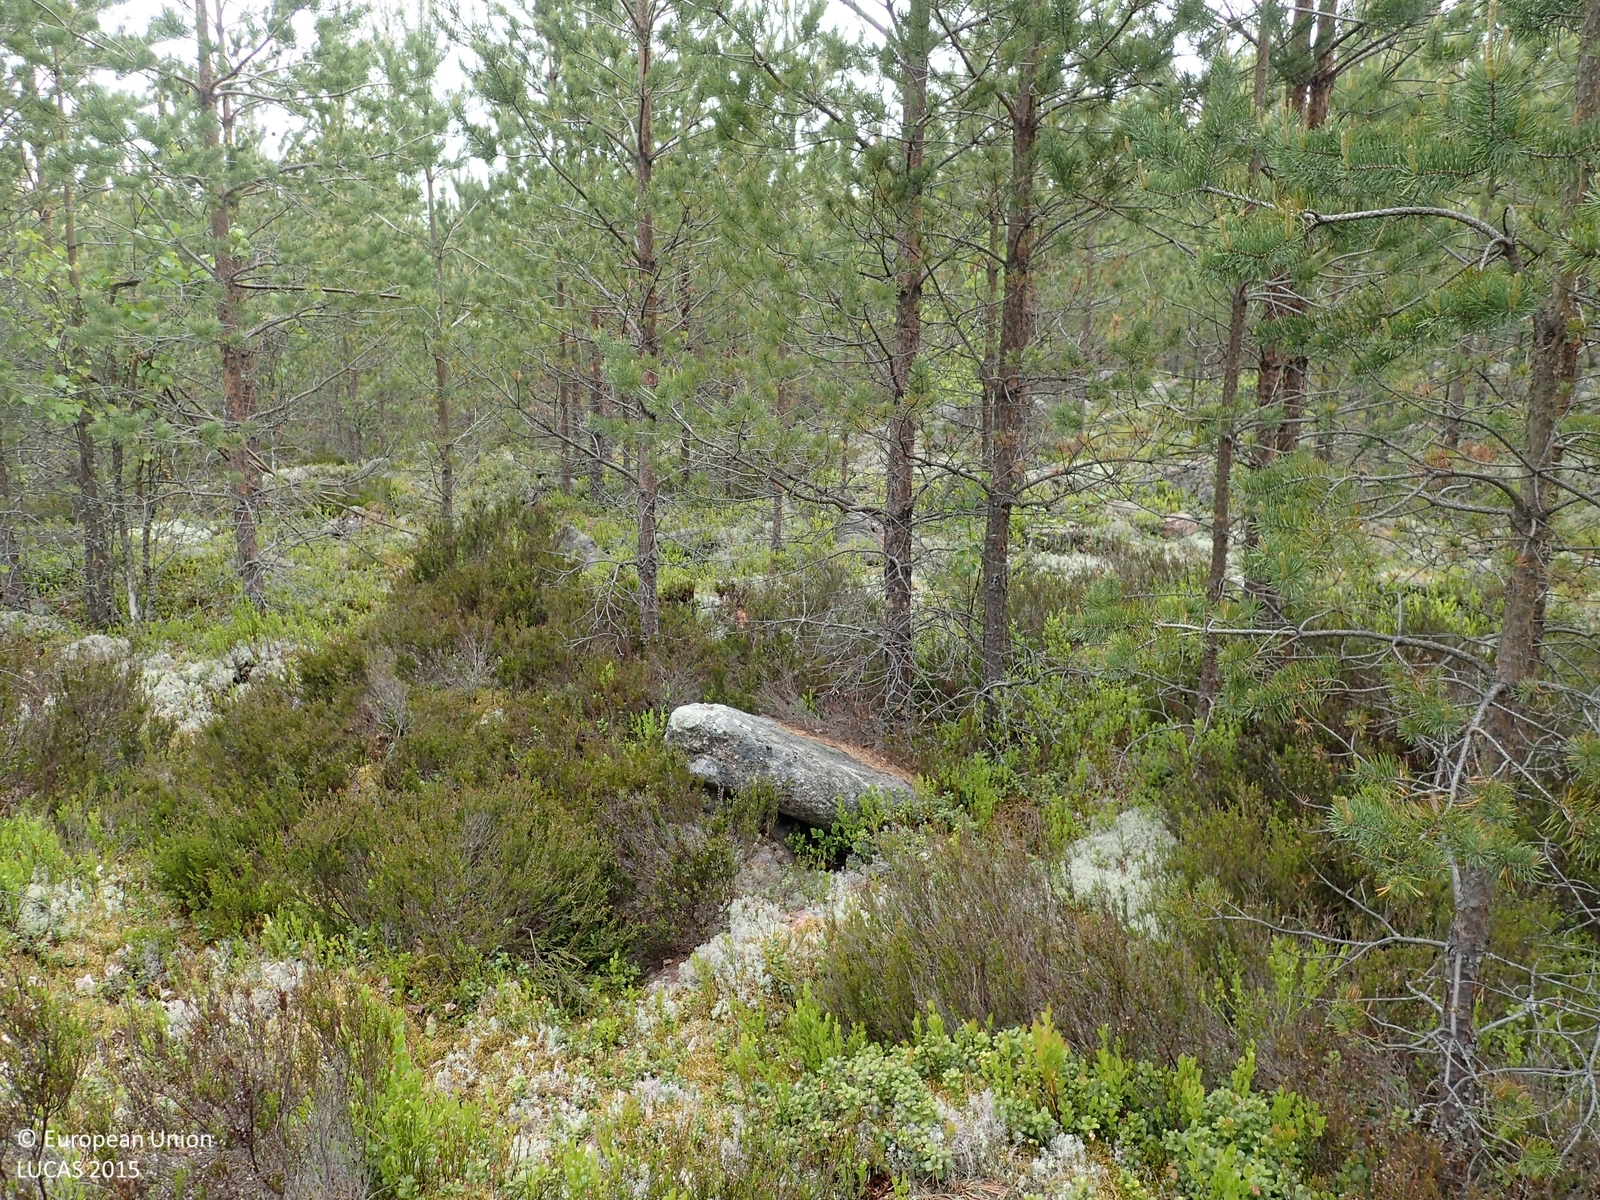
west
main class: Woodland
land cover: Pine dominated coniferous woodland
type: boreal forest
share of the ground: 50 - 75 %
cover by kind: coniferous forest trees 60 %, shrubs 25 %, broadleaved forest trees 5 %, lichens and mosses 5 %, consolidated bare surface 5 %
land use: Forestry
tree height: < 5 m
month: June
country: FI
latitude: 62.4566
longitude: 22.4812
